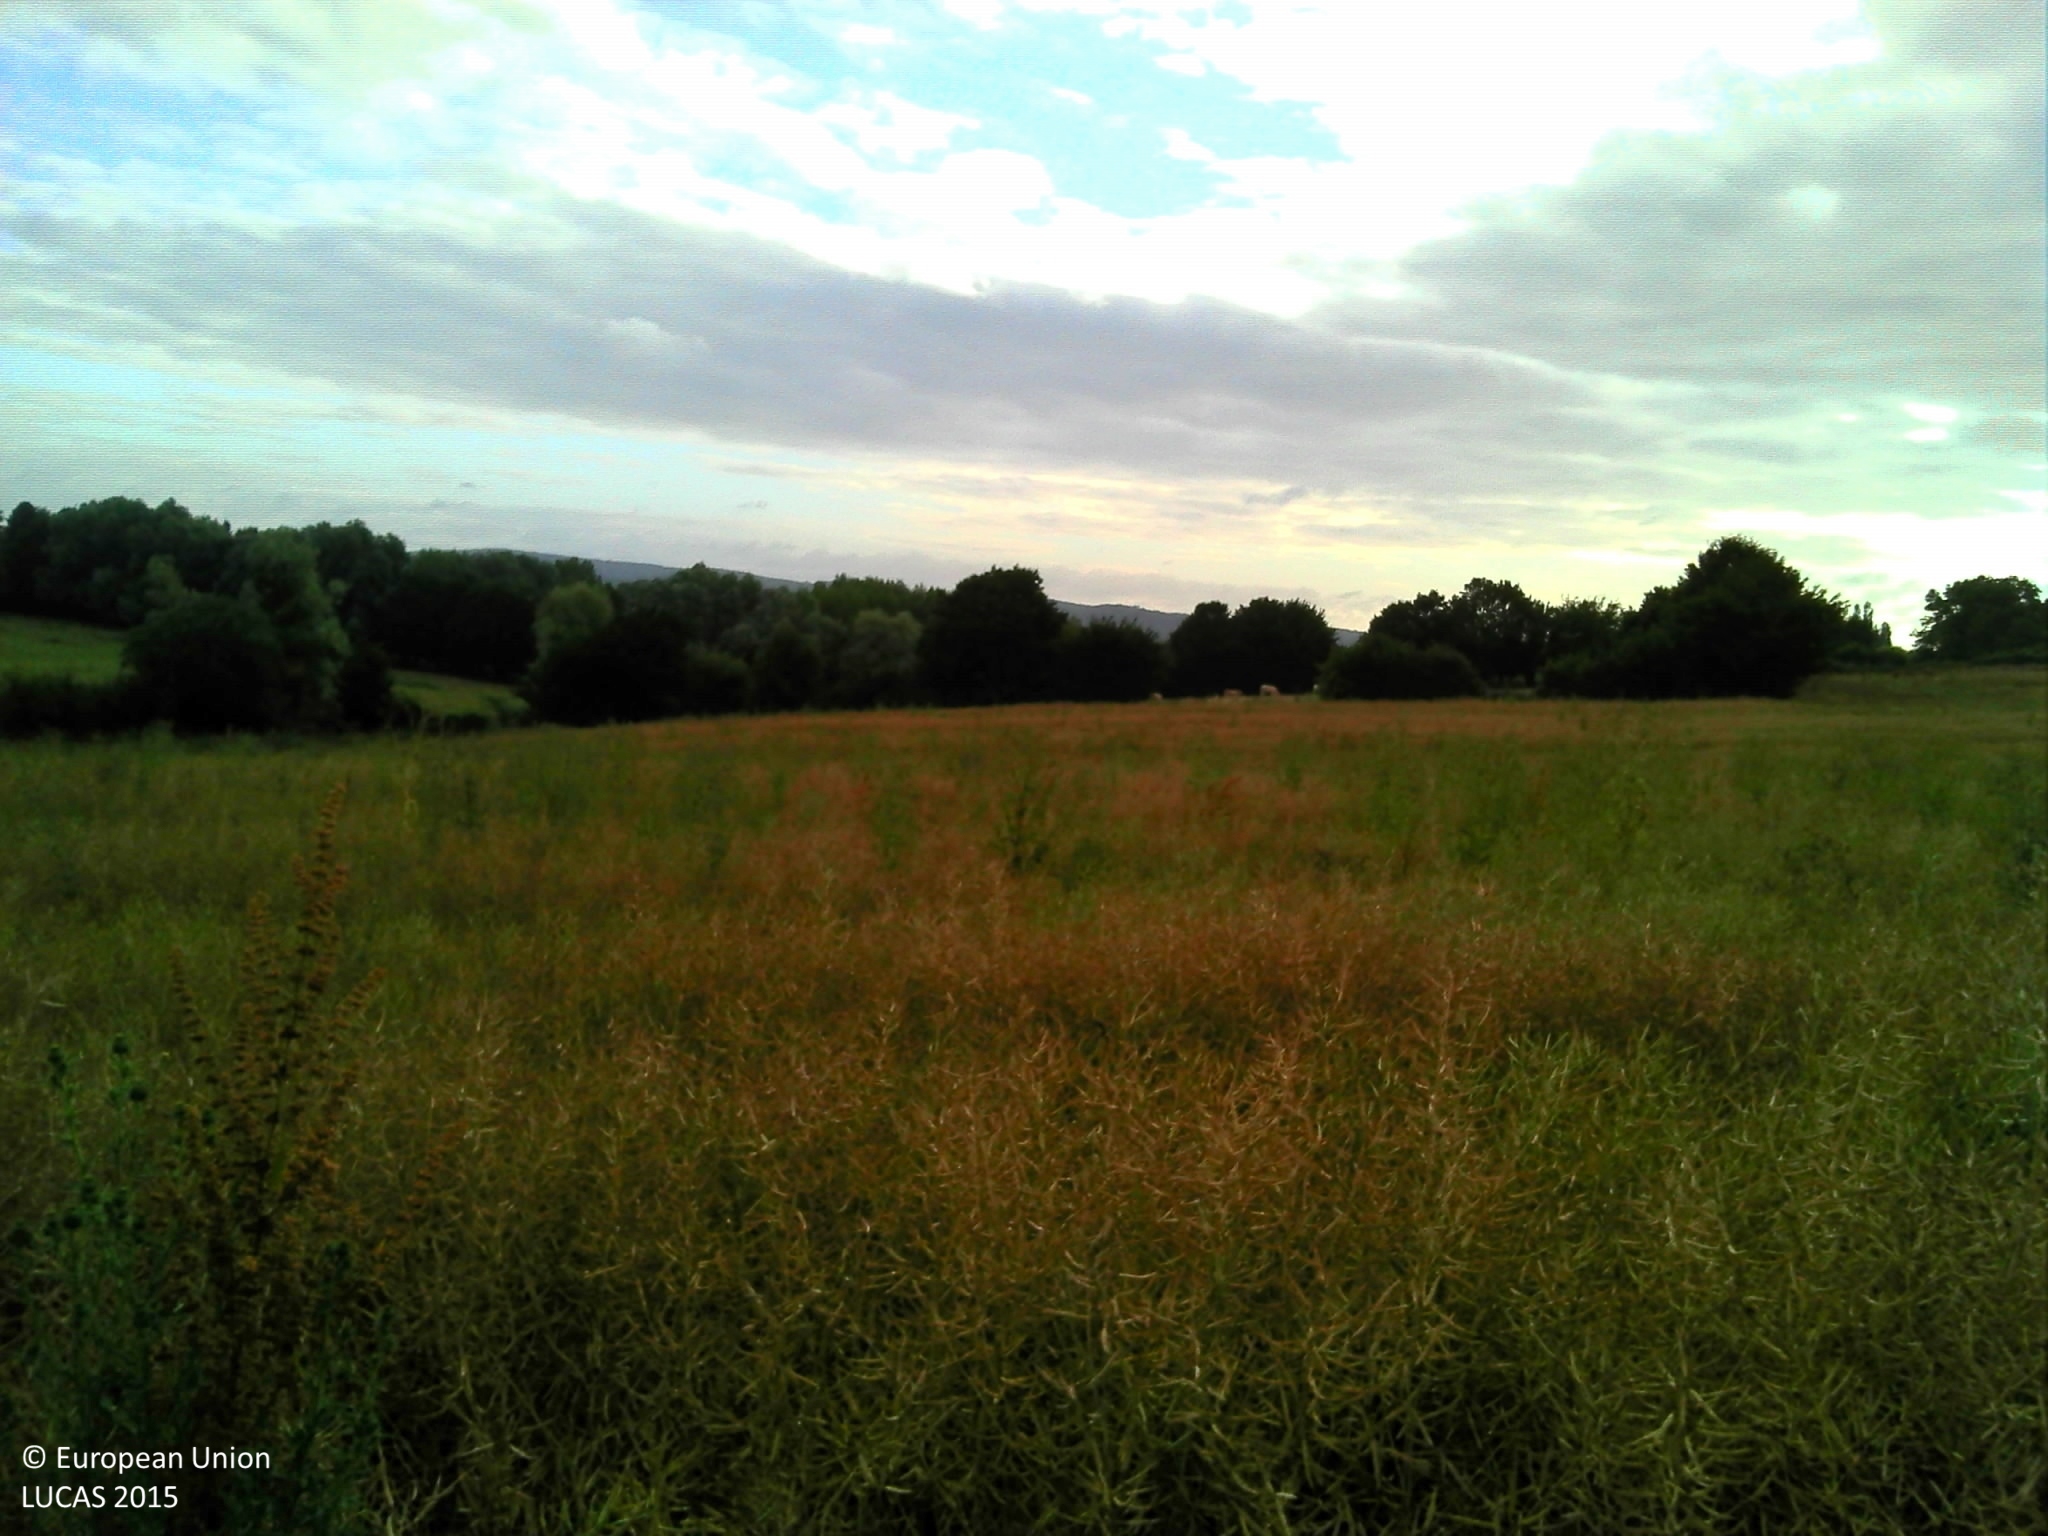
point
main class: Cropland
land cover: Rape and turnip rape
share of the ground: > 75 %
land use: Agriculture (excluding fallow land and kitchen gardens)
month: July
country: FR
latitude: 49.4093
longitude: 1.9218
